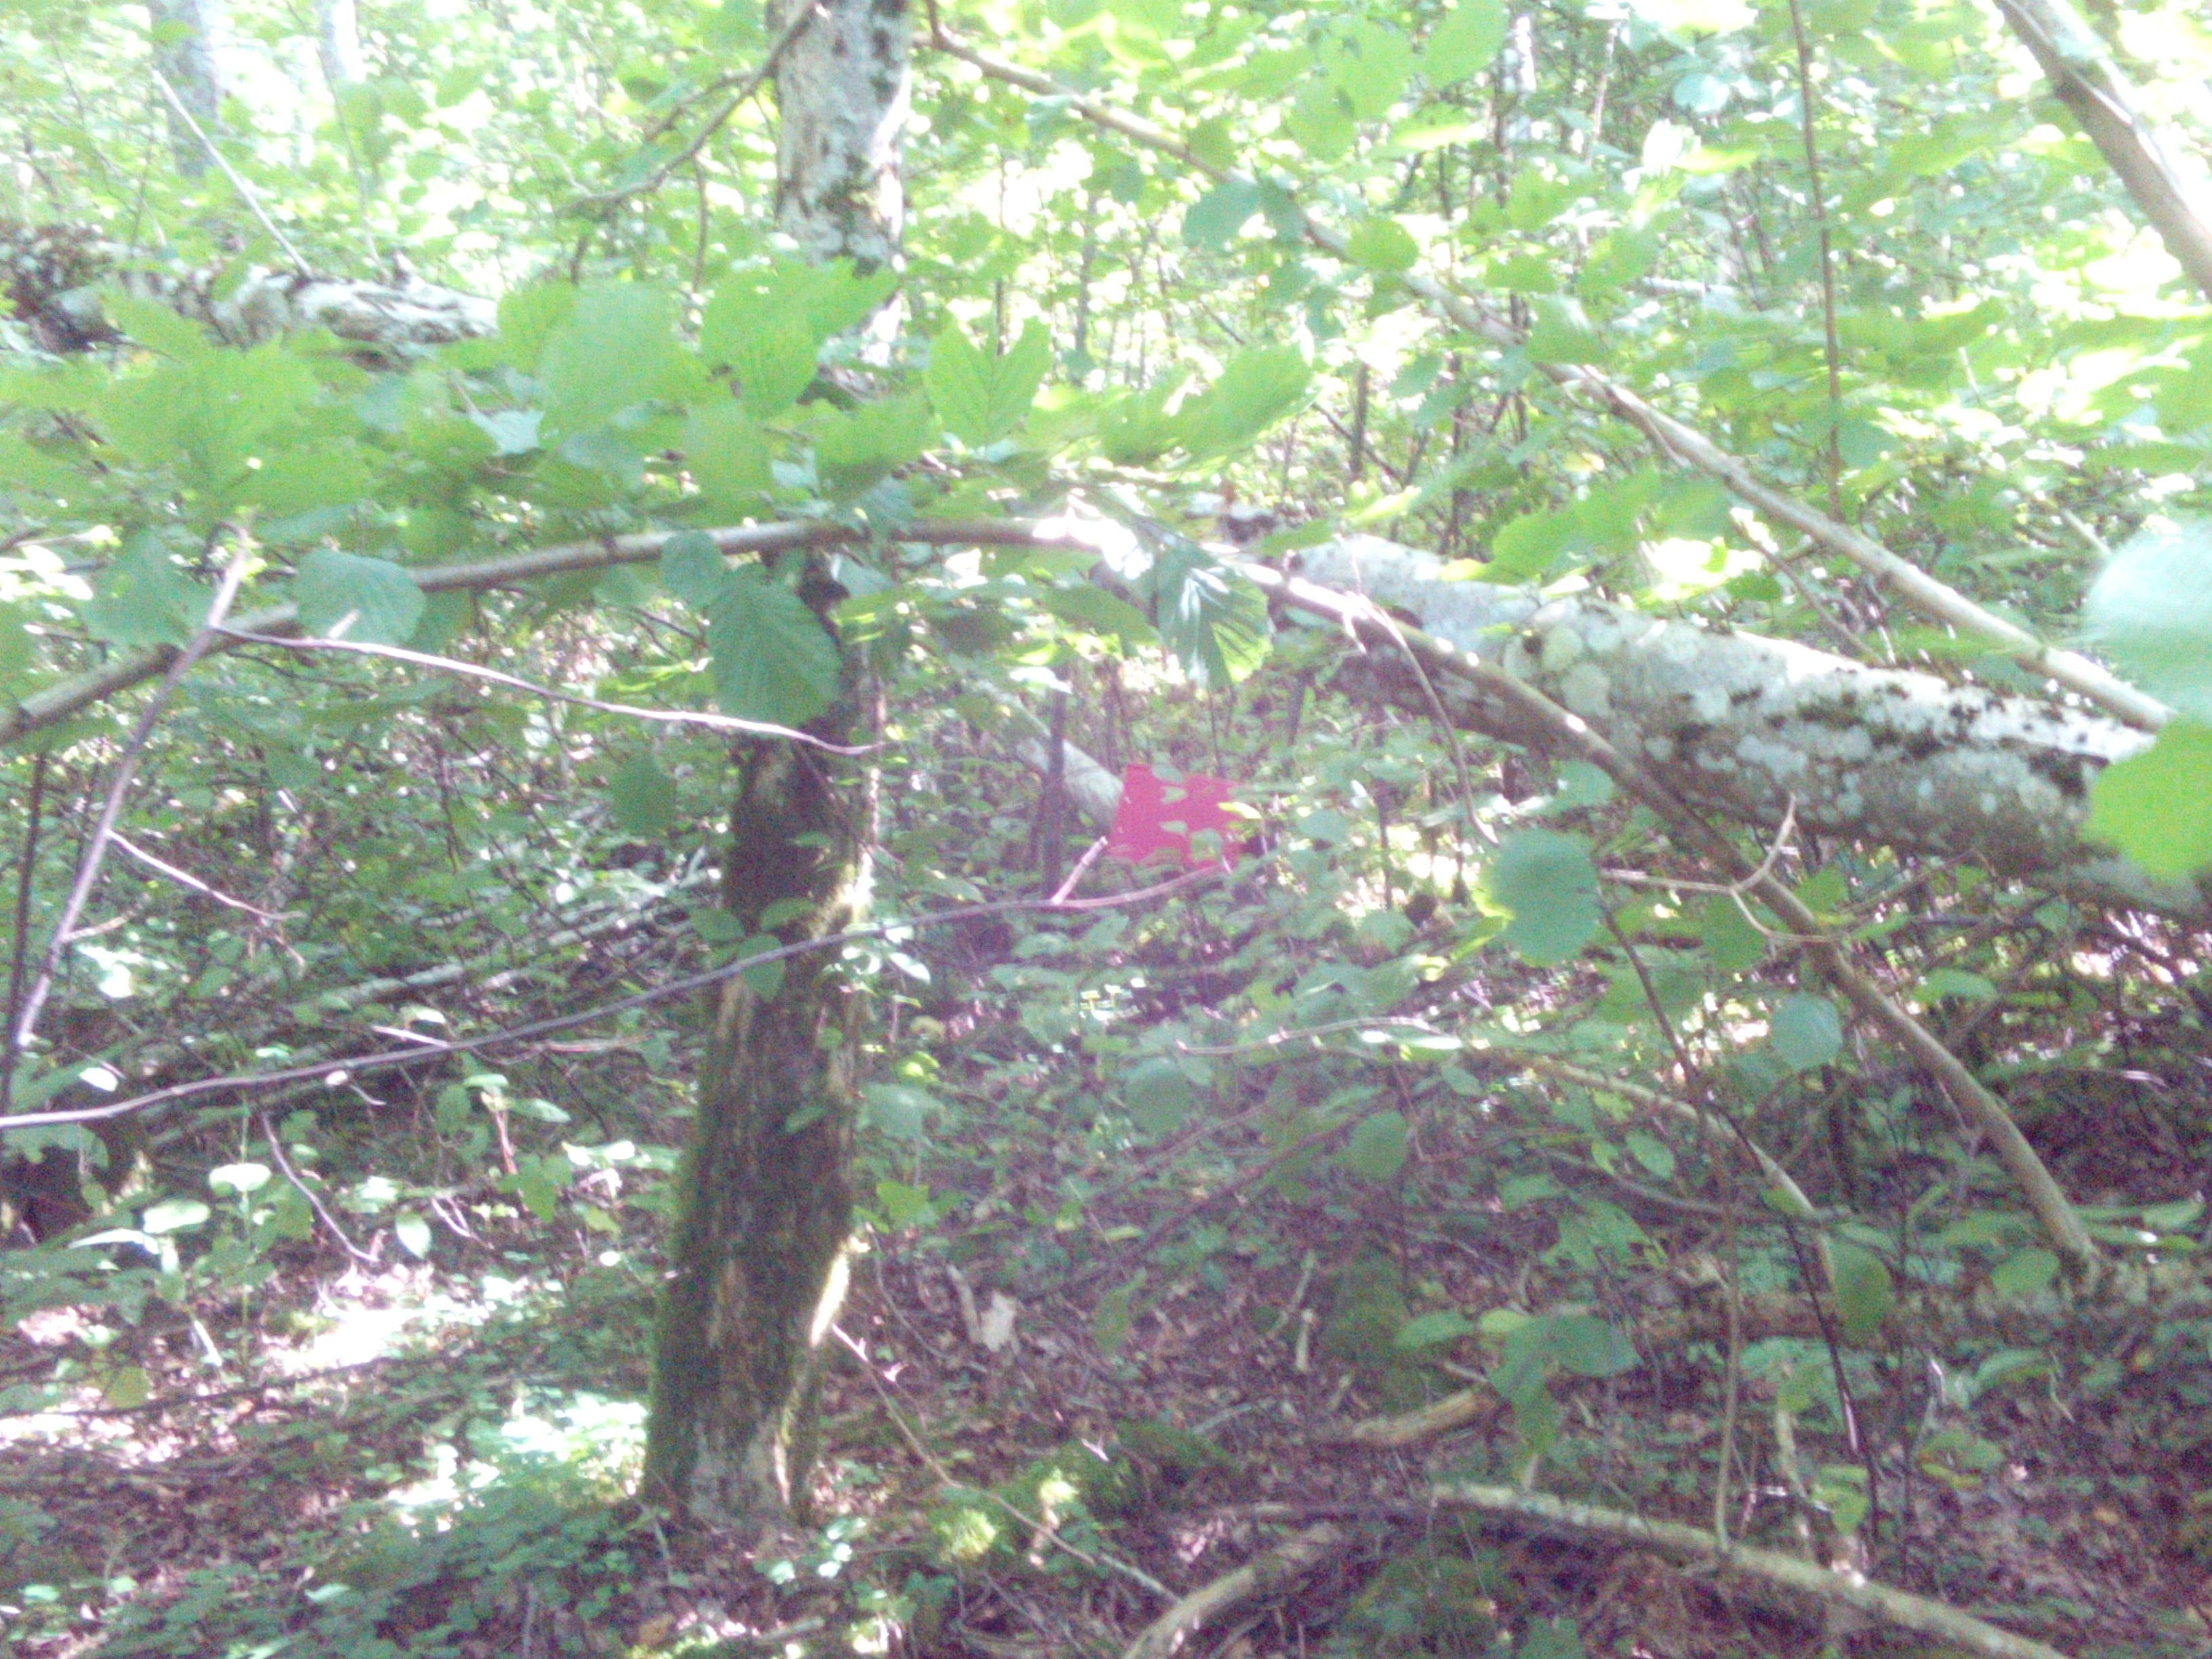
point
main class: Woodland
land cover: Broadleaved woodland
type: non-riverine alder, birch or aspen forest
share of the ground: > 75 %
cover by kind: broadleaved forest trees 95 %, herbaceous plants 5 %
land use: Forestry
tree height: > 5 m
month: August
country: LV
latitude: 56.4992
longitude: 21.3632
